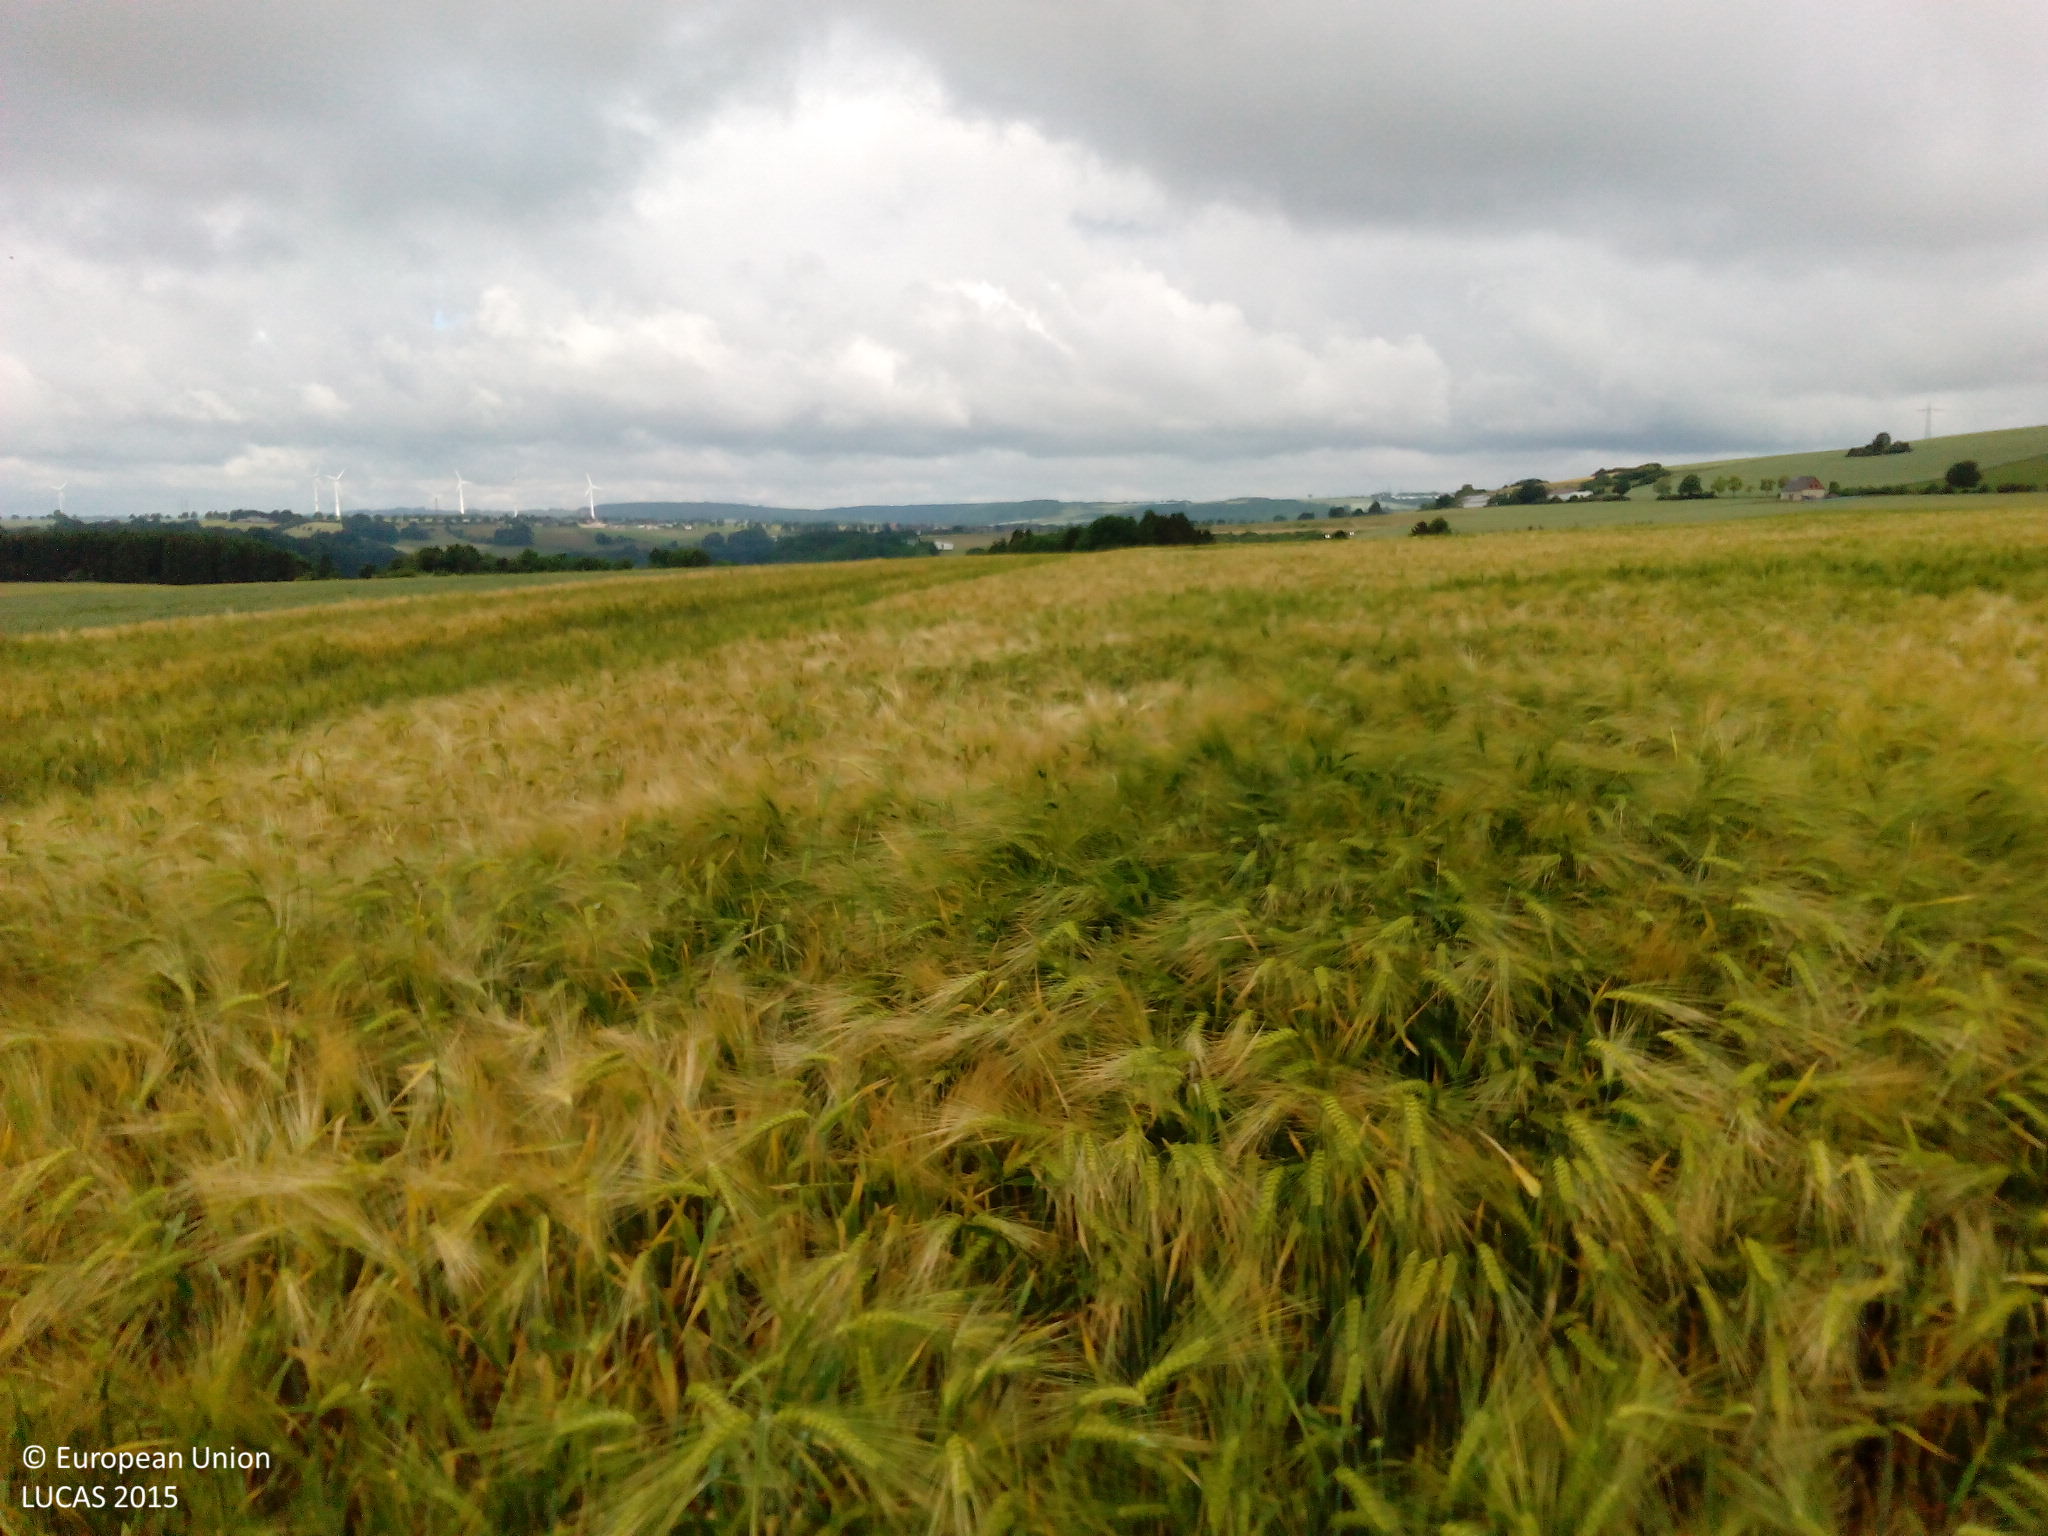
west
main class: Cropland
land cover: Barley
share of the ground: > 75 %
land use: Agriculture (excluding fallow land and kitchen gardens)
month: June
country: DE
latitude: 51.5423
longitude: 8.6017
